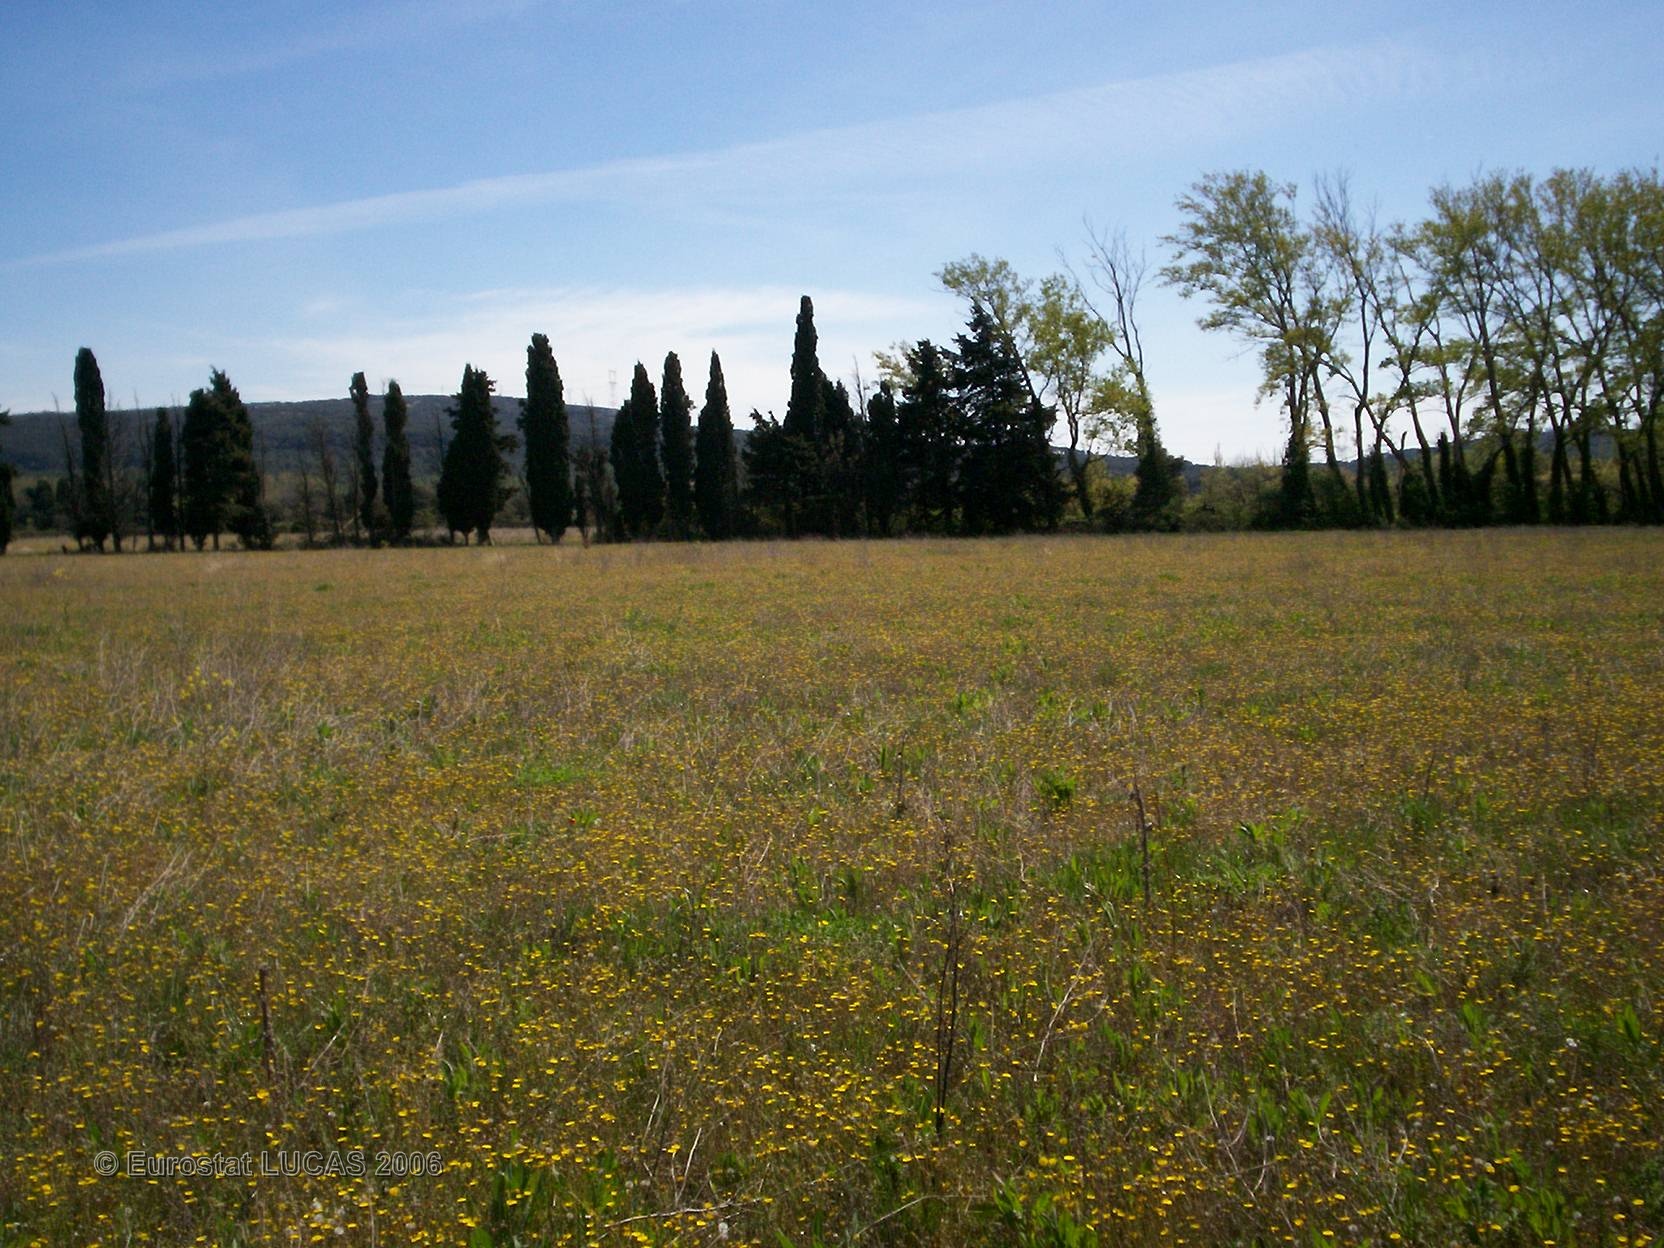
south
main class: Grassland
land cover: Grassland without tree/shrub cover
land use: Agriculture (excluding fallow land and kitchen gardens)
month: April
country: FR
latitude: 43.7268
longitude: 5.0560
